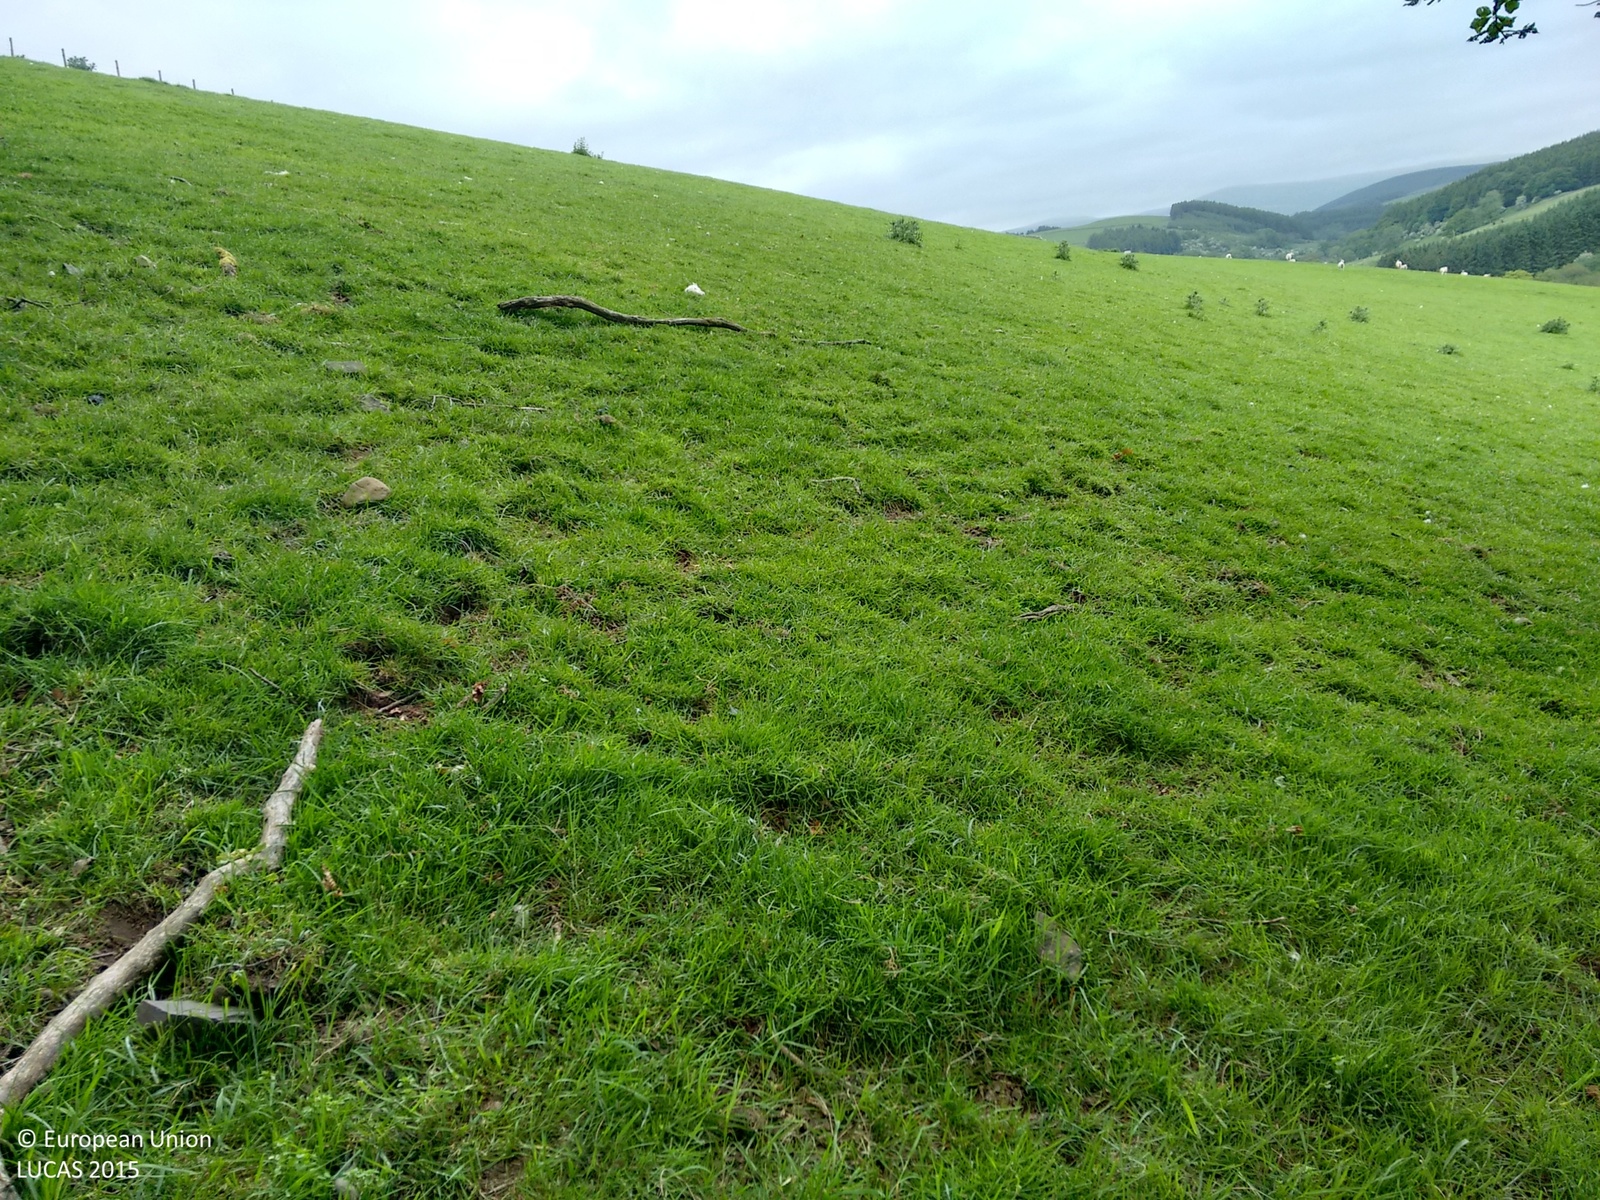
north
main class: Woodland
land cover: Broadleaved woodland
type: mesophytic deciduous forest
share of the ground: > 75 %
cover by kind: broadleaved forest trees 80 %, herbaceous plants 20 %
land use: Agriculture (excluding fallow land and kitchen gardens)
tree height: > 5 m
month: June
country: GB
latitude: 55.1921
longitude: -3.7031
